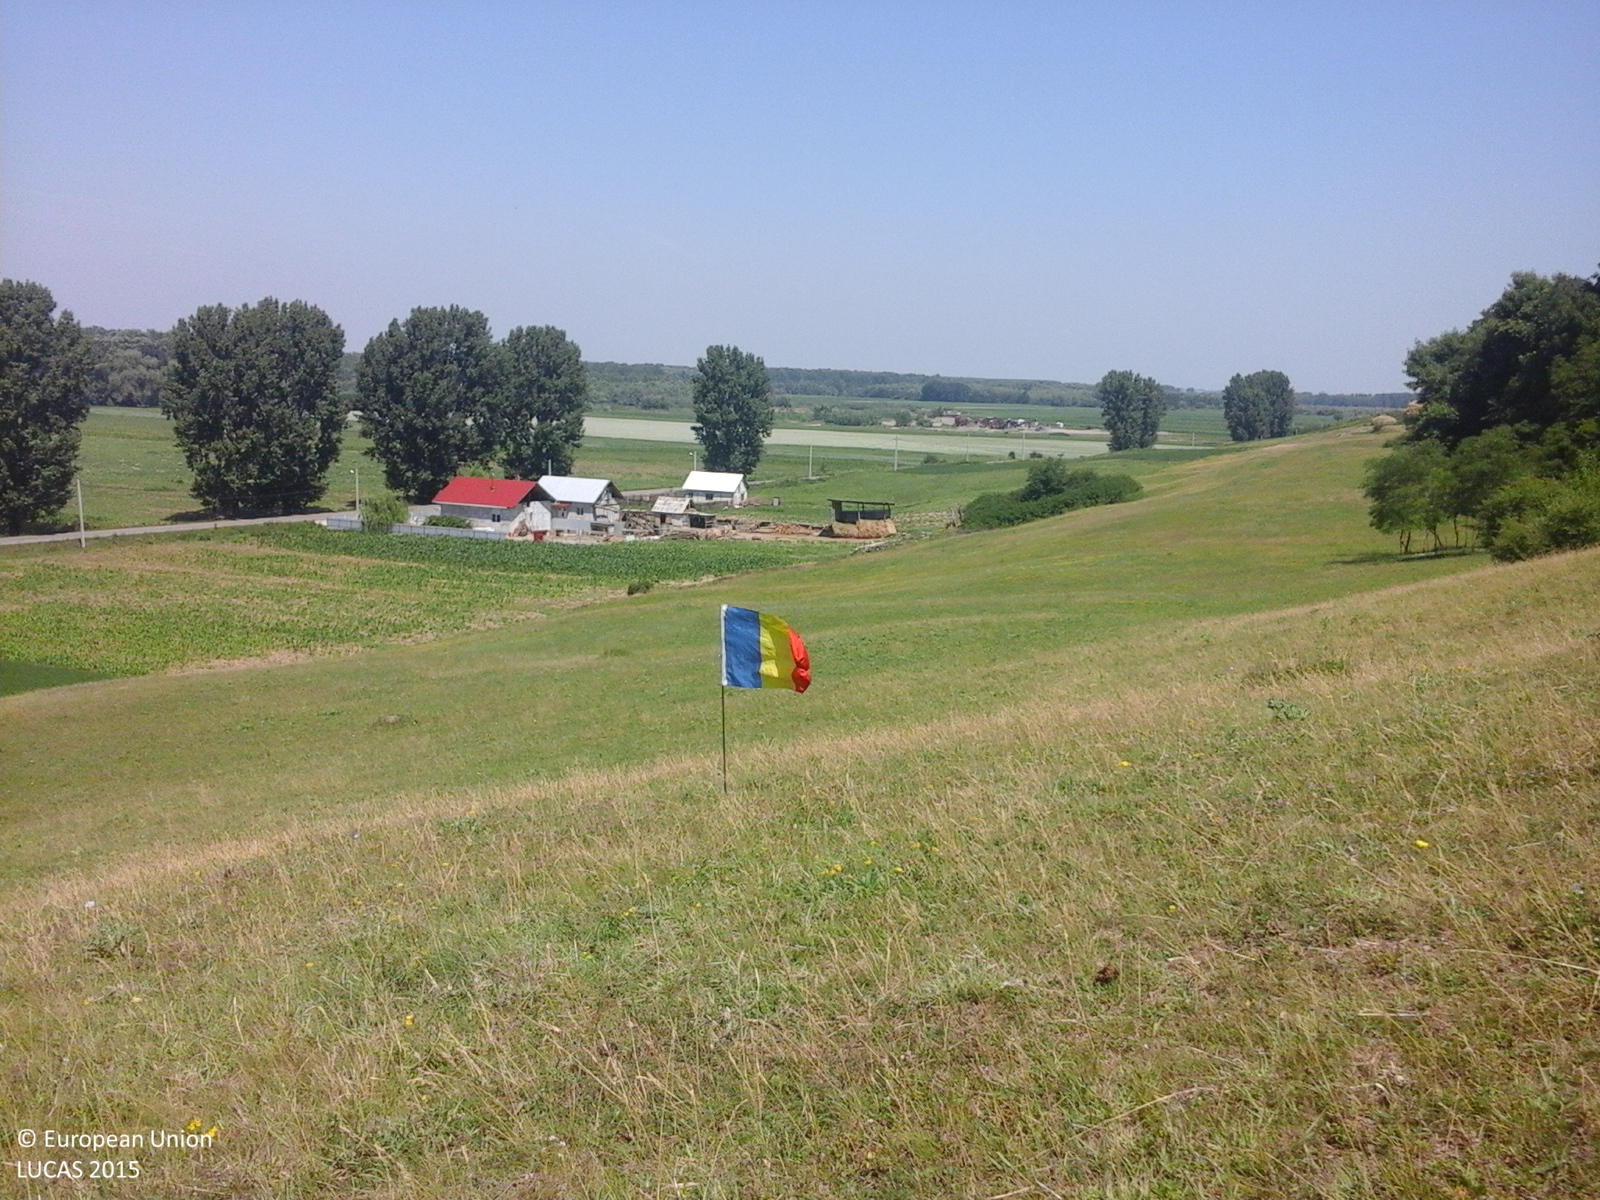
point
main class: Grassland
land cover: Grassland without tree/shrub cover
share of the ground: > 75 %
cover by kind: herbaceous plants 100 %
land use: Agriculture (excluding fallow land and kitchen gardens)
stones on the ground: < 10 %
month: June
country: RO
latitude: 46.8259
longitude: 26.9413
